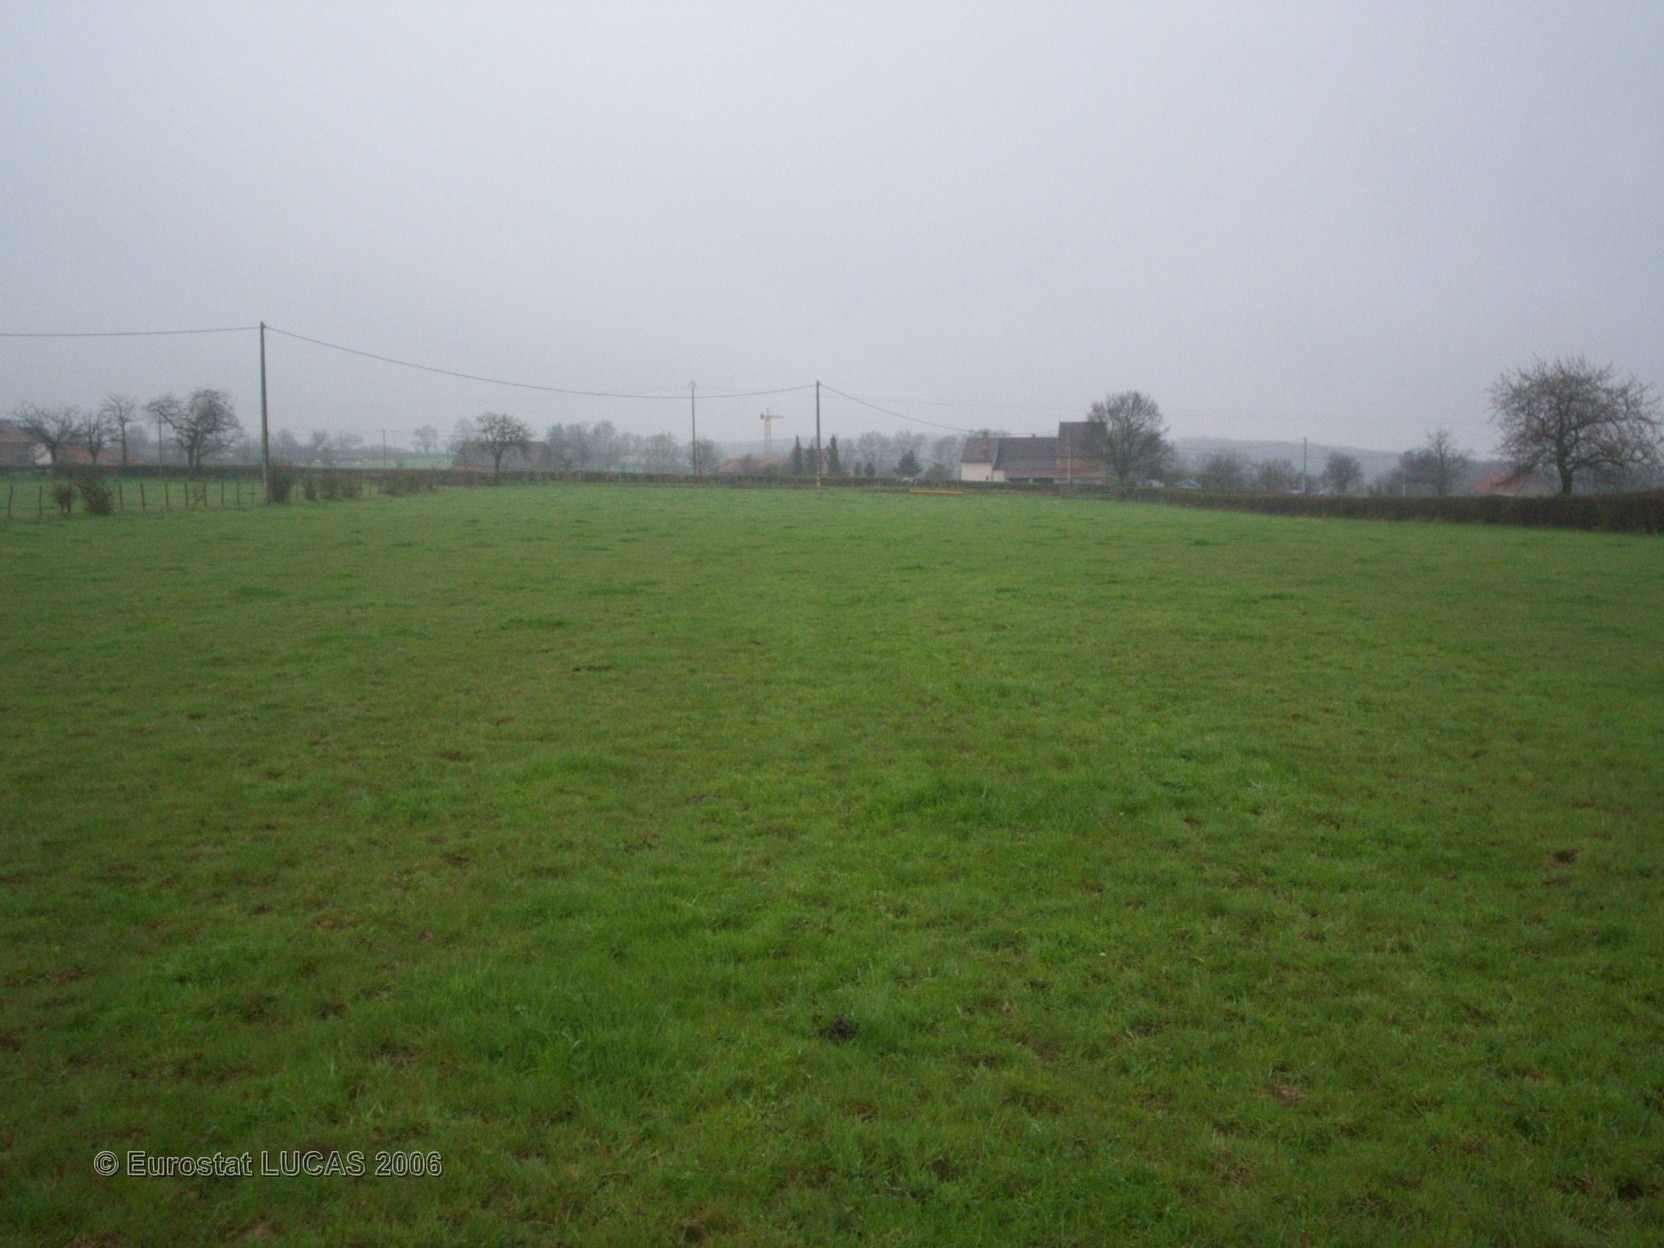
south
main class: Grassland
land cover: Grassland without tree/shrub cover
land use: Agriculture (excluding fallow land and kitchen gardens)
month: April
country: FR
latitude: 46.2770
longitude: 4.0703
